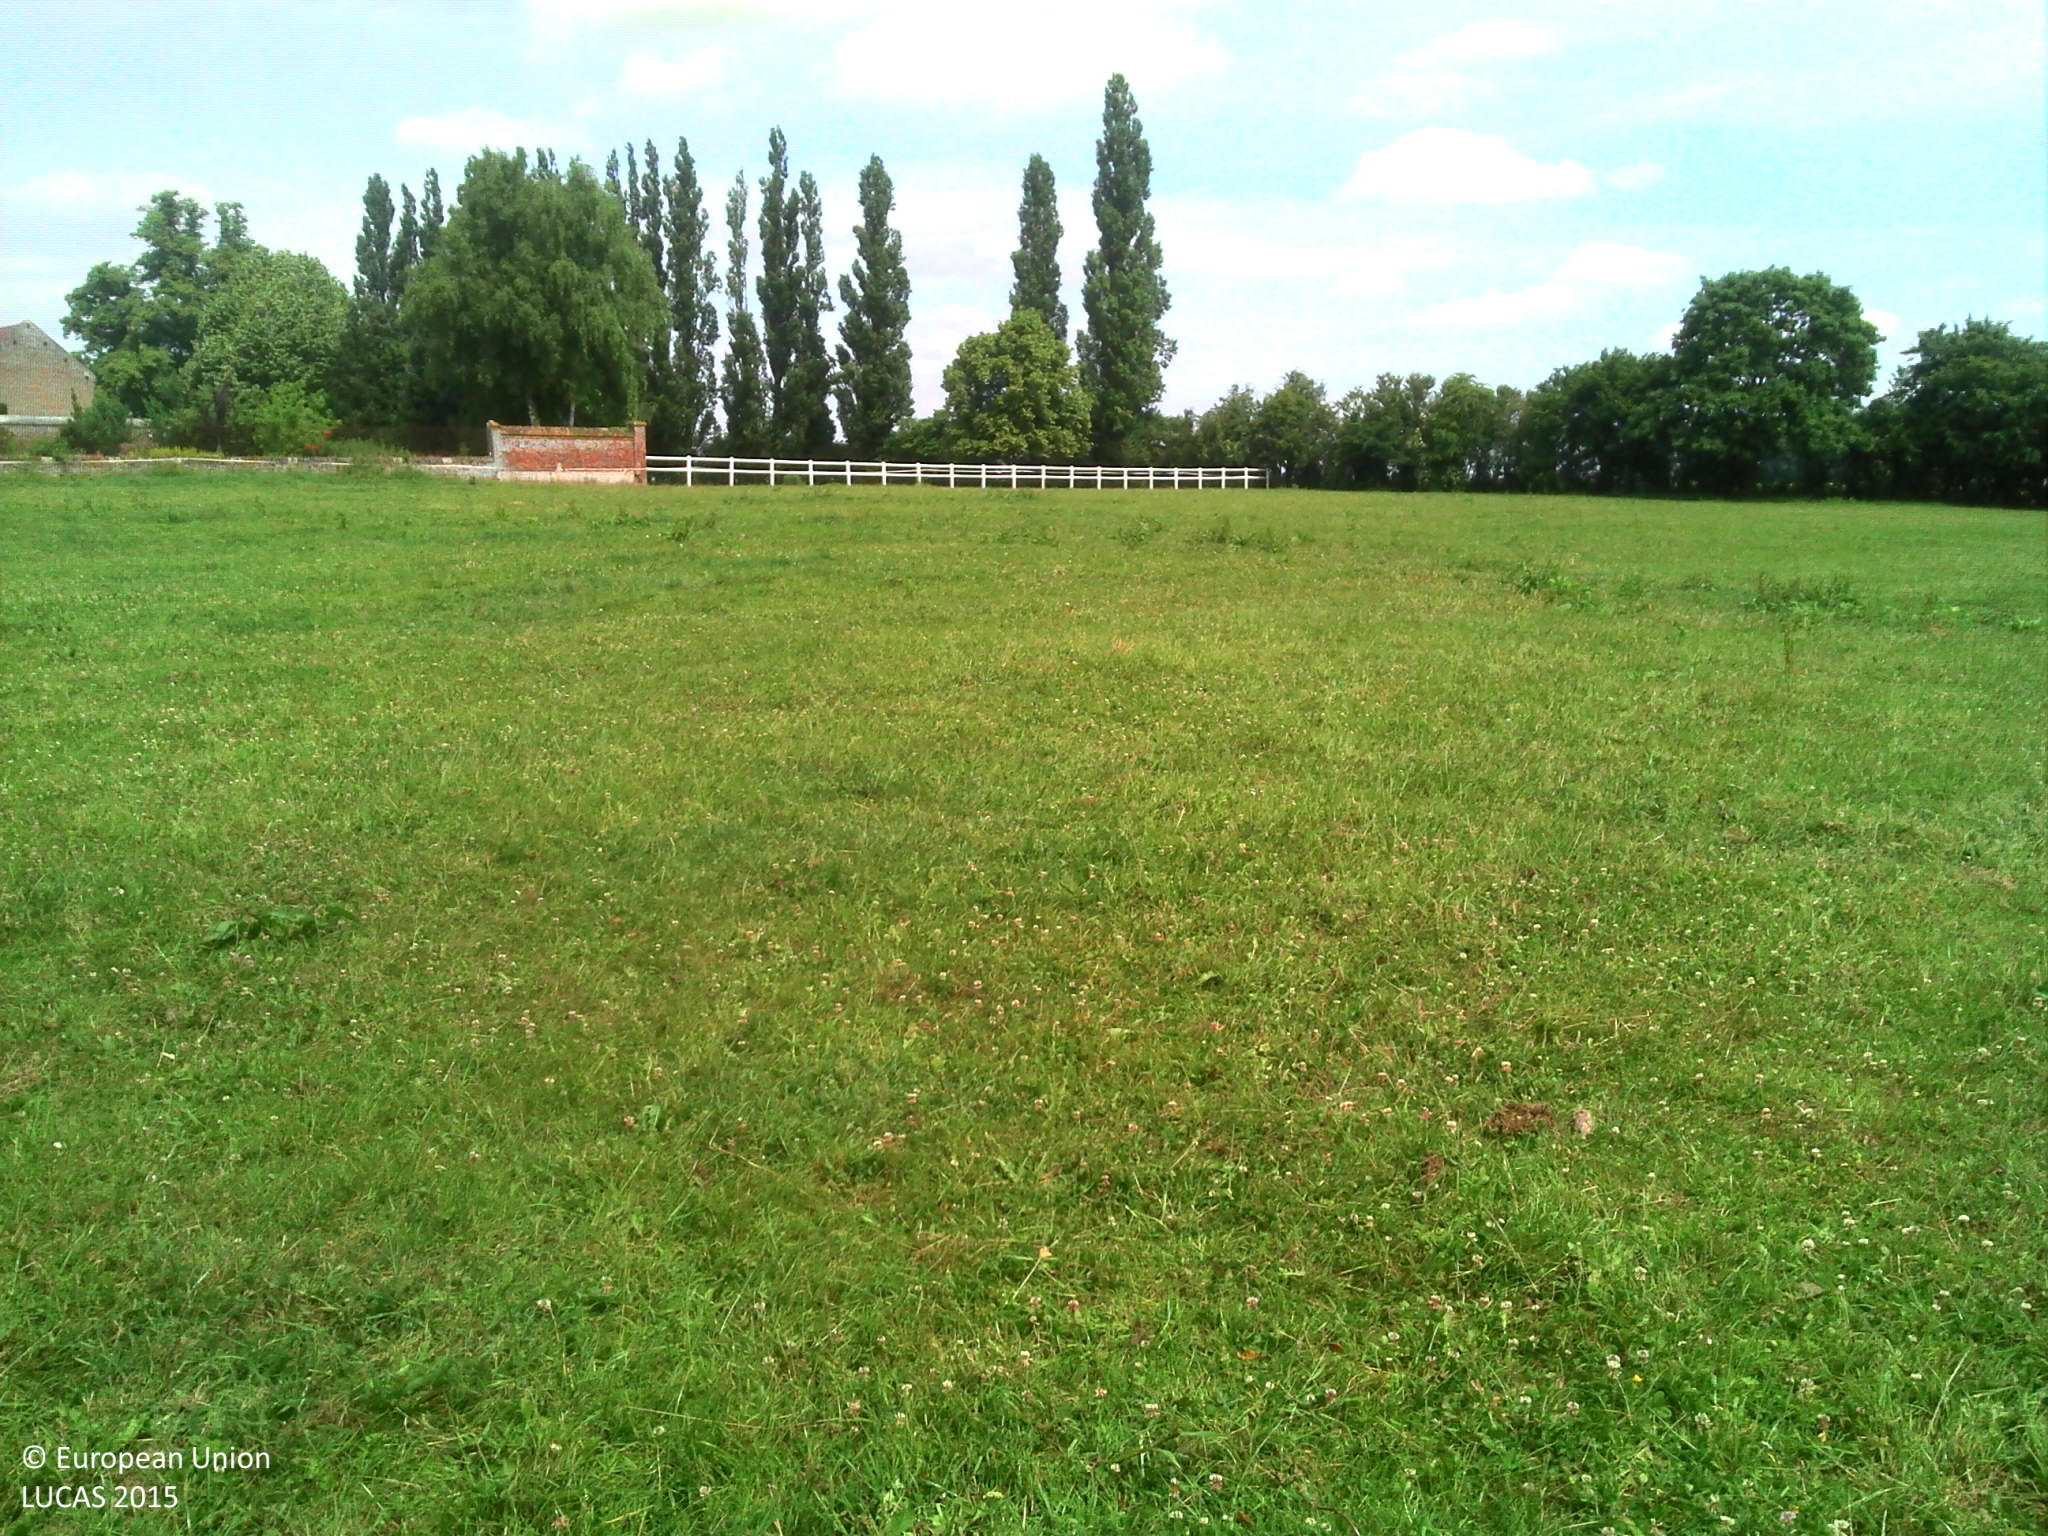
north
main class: Grassland
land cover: Grassland without tree/shrub cover
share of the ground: > 75 %
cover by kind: herbaceous plants 100 %
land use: Agriculture (excluding fallow land and kitchen gardens)
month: June
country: FR
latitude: 49.6902
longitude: 2.3211
